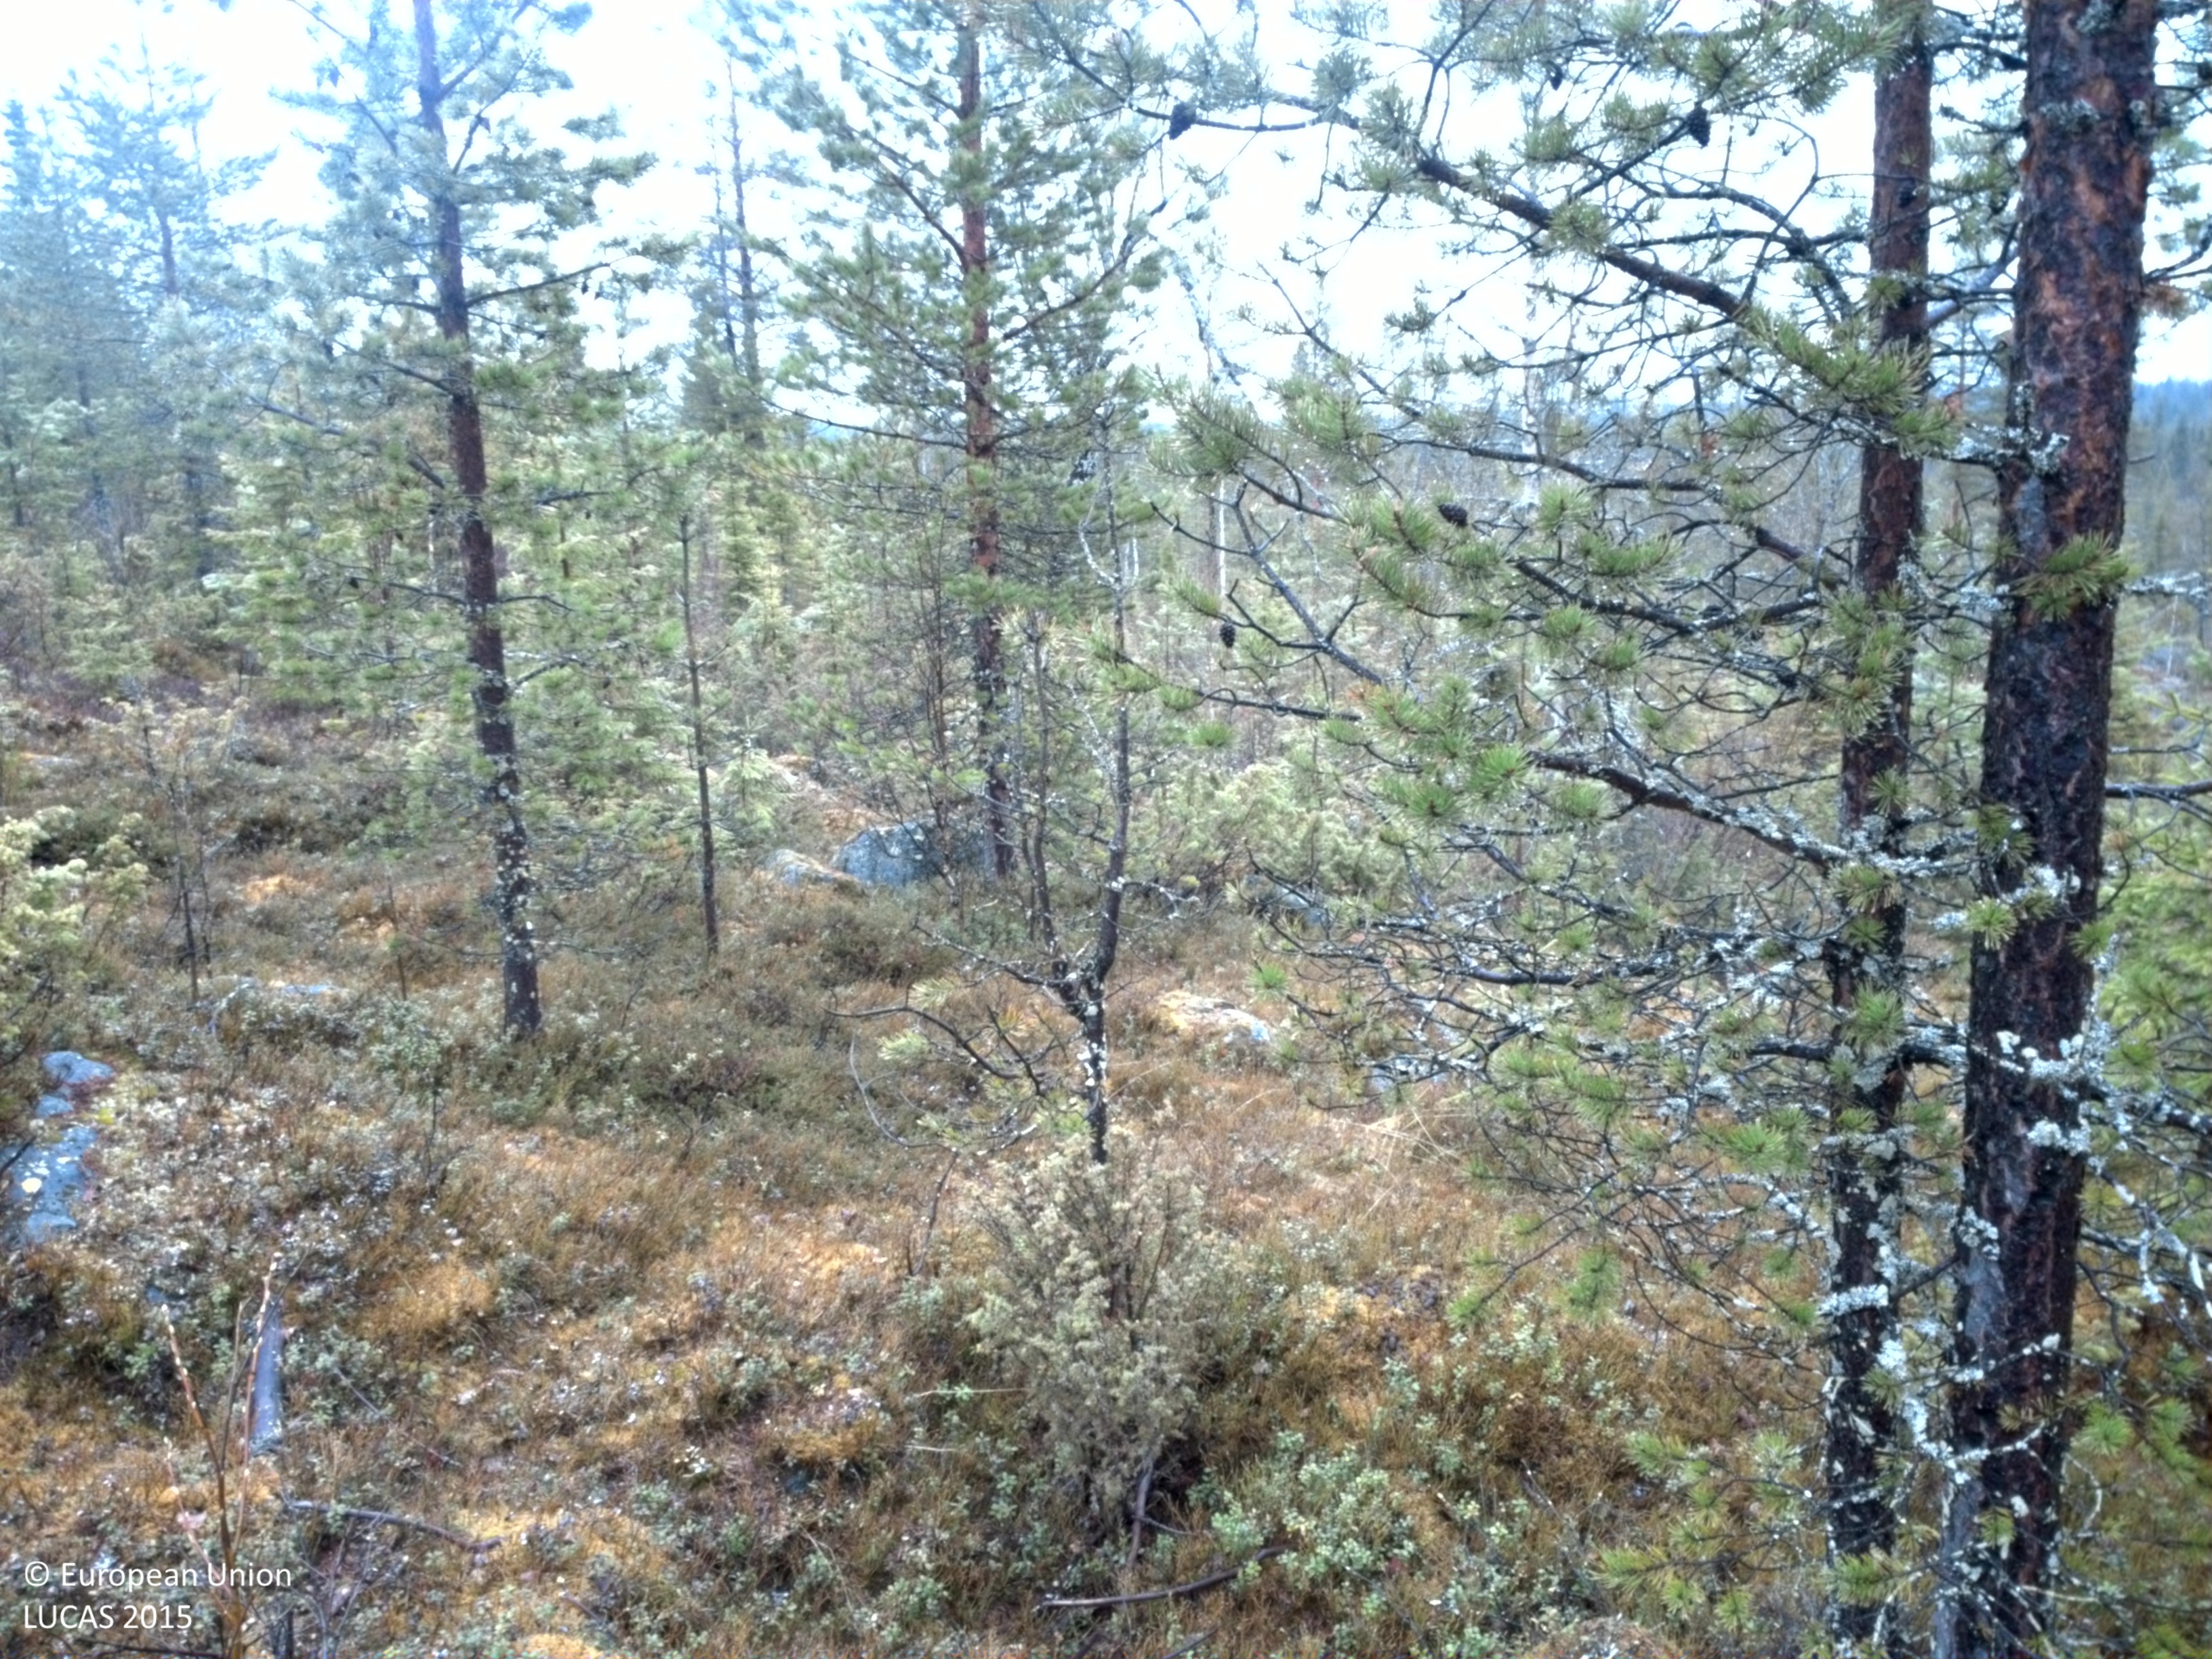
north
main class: Woodland
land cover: Pine dominated coniferous woodland
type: boreal forest
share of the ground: > 75 %
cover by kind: coniferous forest trees 75 %, shrubs 25 %
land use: Forestry
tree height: < 5 m
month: May
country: SE
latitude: 66.2579
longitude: 23.3627
